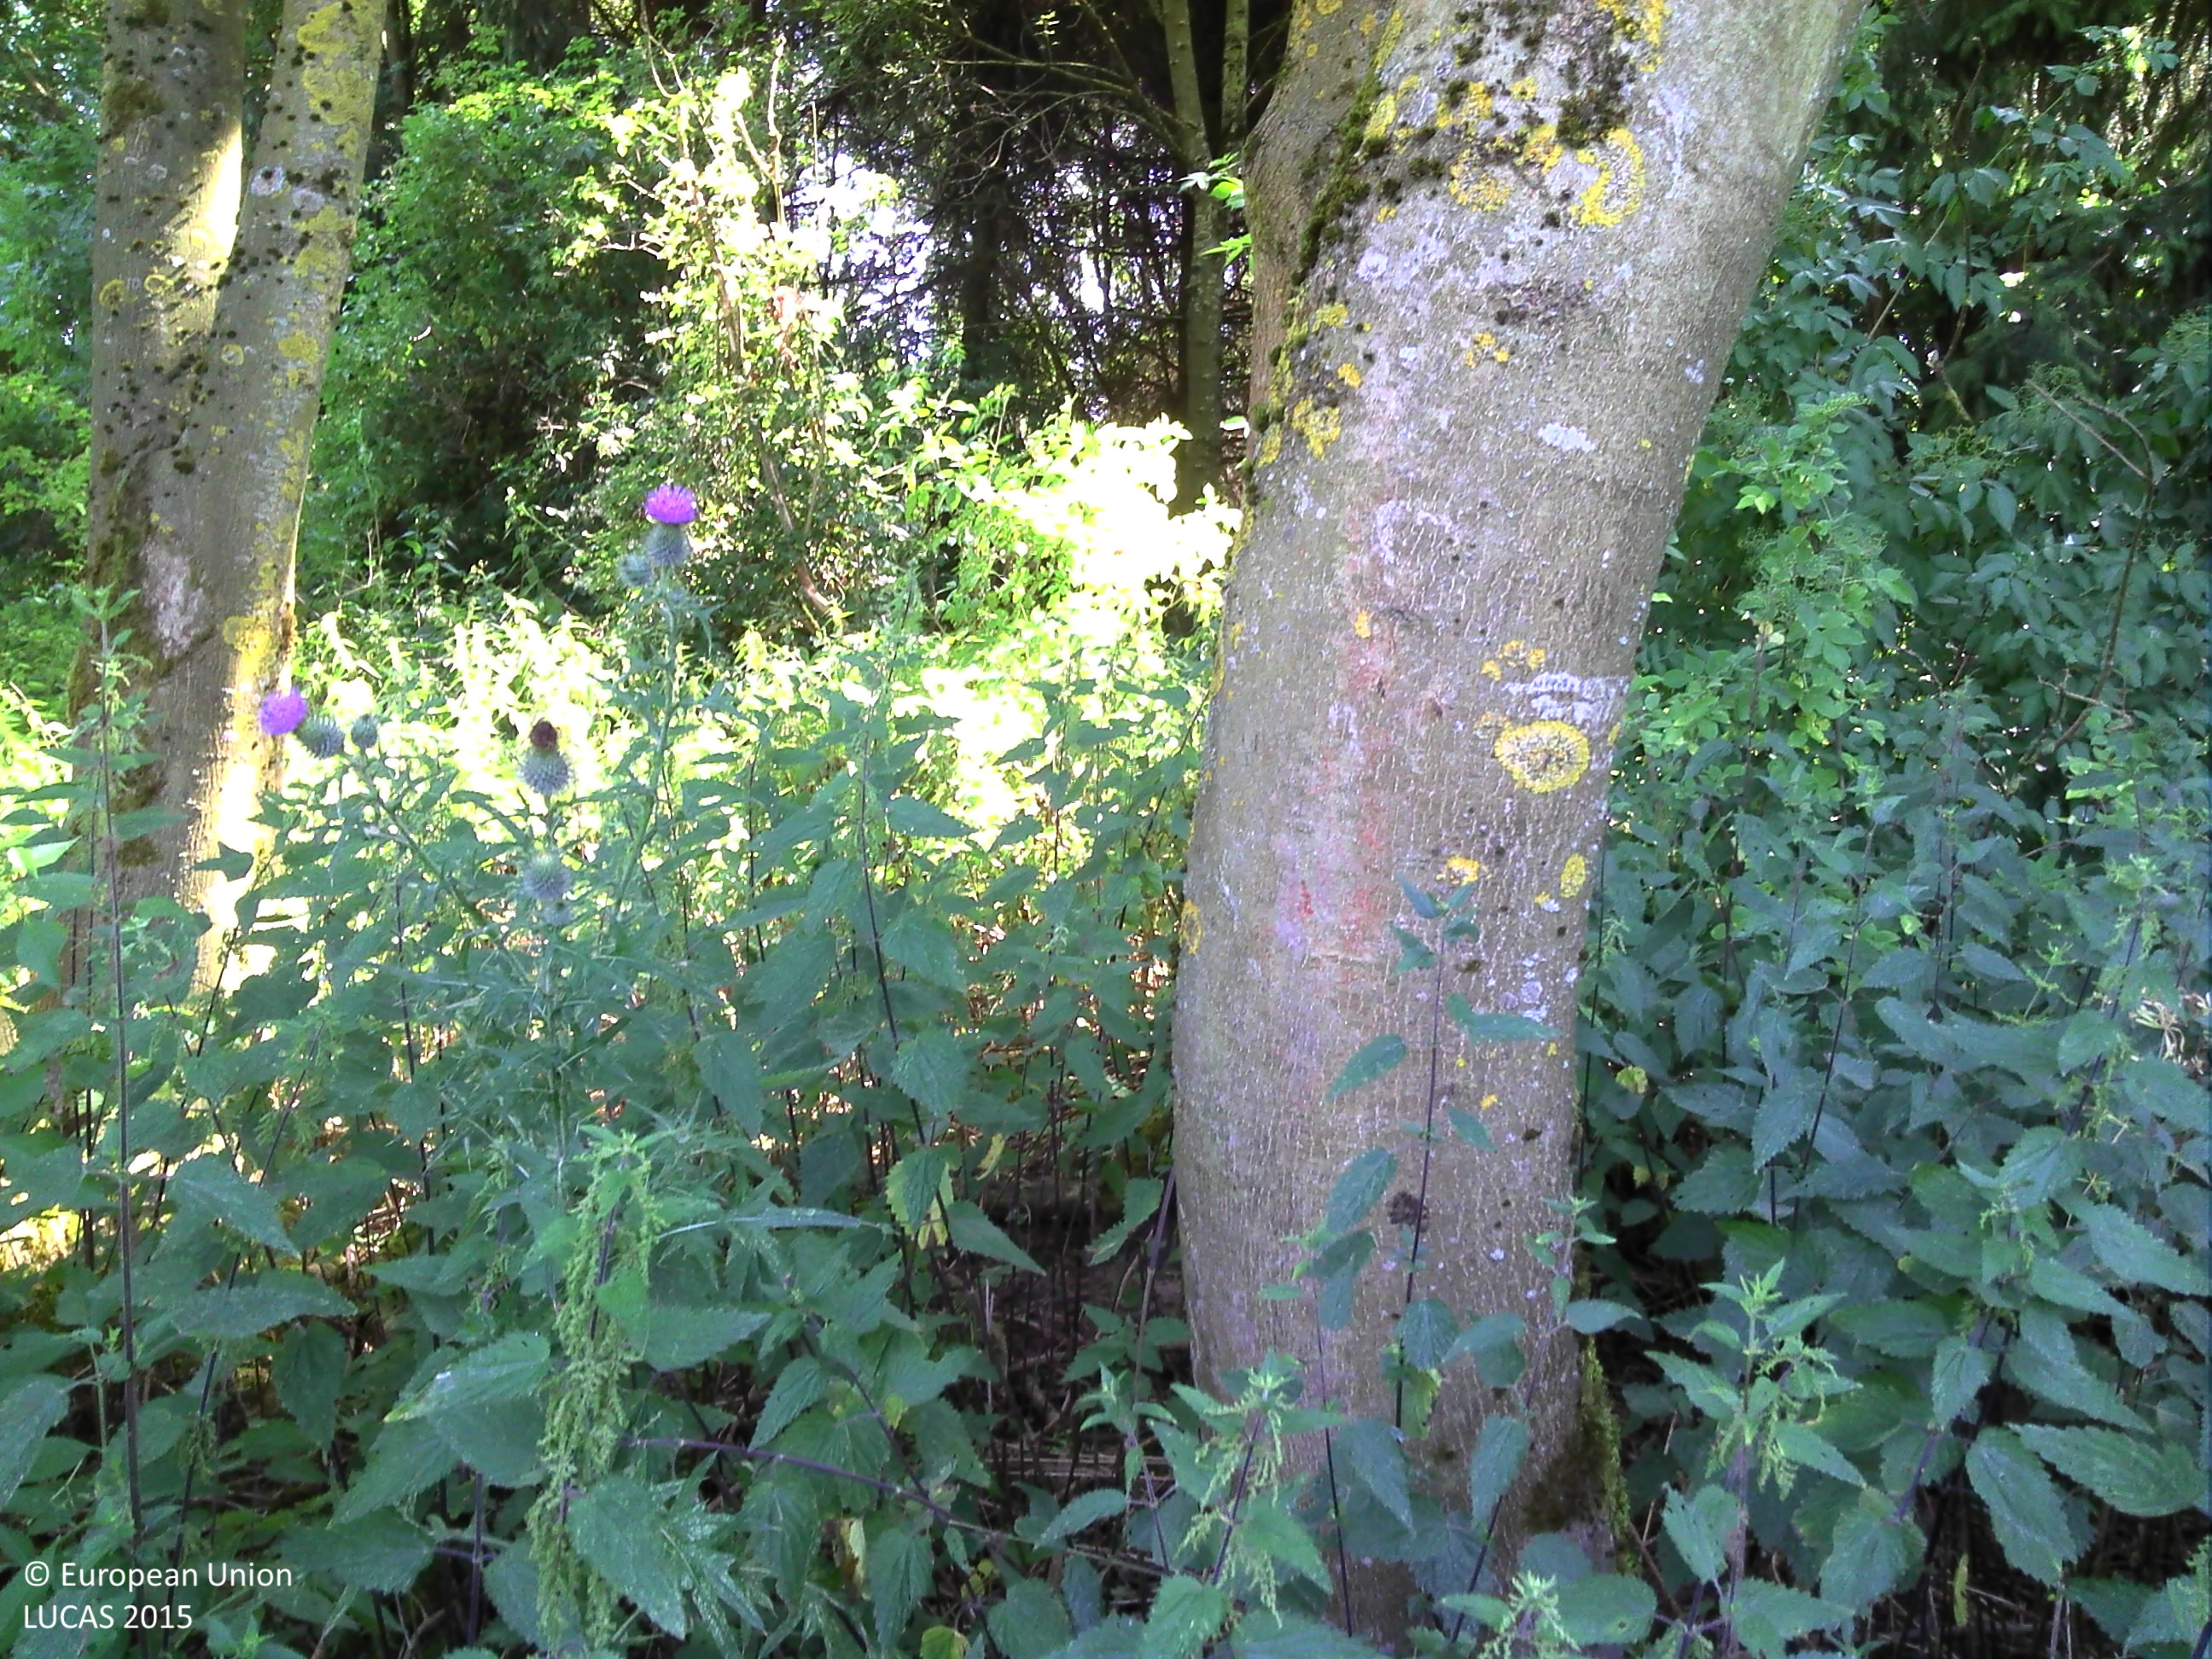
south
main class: Woodland
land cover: Broadleaved woodland
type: mesophytic deciduous forest
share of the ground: > 75 %
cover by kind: broadleaved forest trees 80 %, coniferous forest trees 20 %
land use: Semi-natural and natural areas not in use
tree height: > 5 m
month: July
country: BE
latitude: 50.6618
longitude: 5.7121
